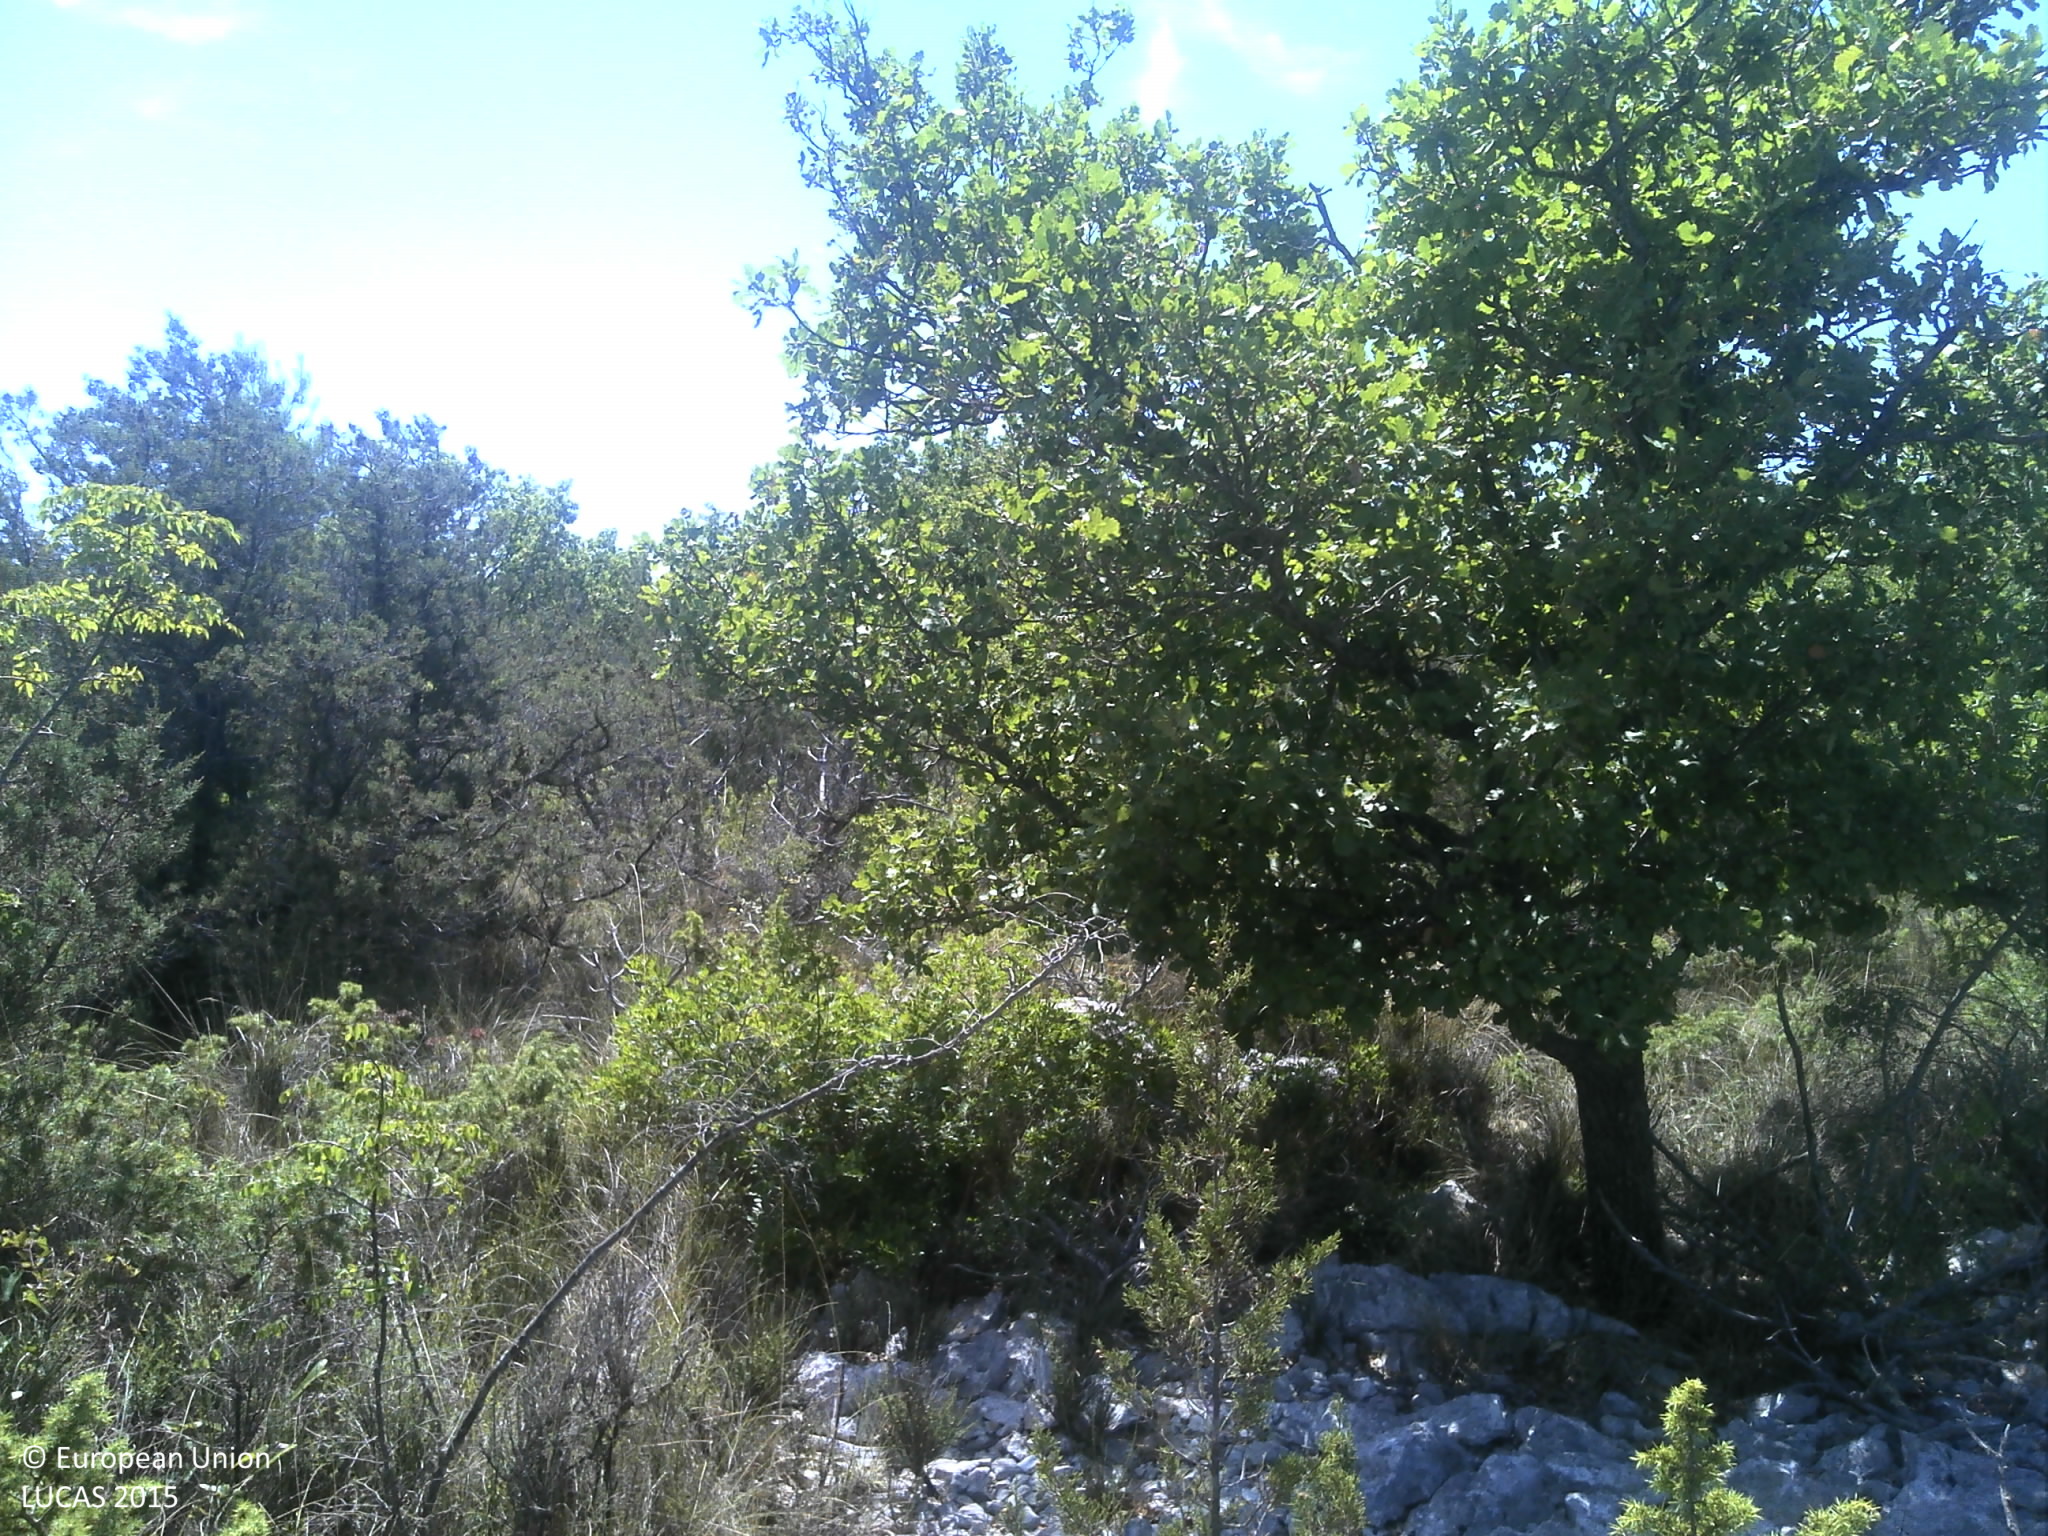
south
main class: Woodland
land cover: Broadleaved woodland
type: thermophilous deciduous forest
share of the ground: 25 - 50 %
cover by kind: shrubs 40 %, broadleaved forest trees 35 %, consolidated bare surface 10 %, unconsolidated bare surface 10 %, herbaceous plants 5 %
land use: Semi-natural and natural areas not in use
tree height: > 5 m
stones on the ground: > 50 %
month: August
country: HR
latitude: 43.8143
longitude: 15.6976
